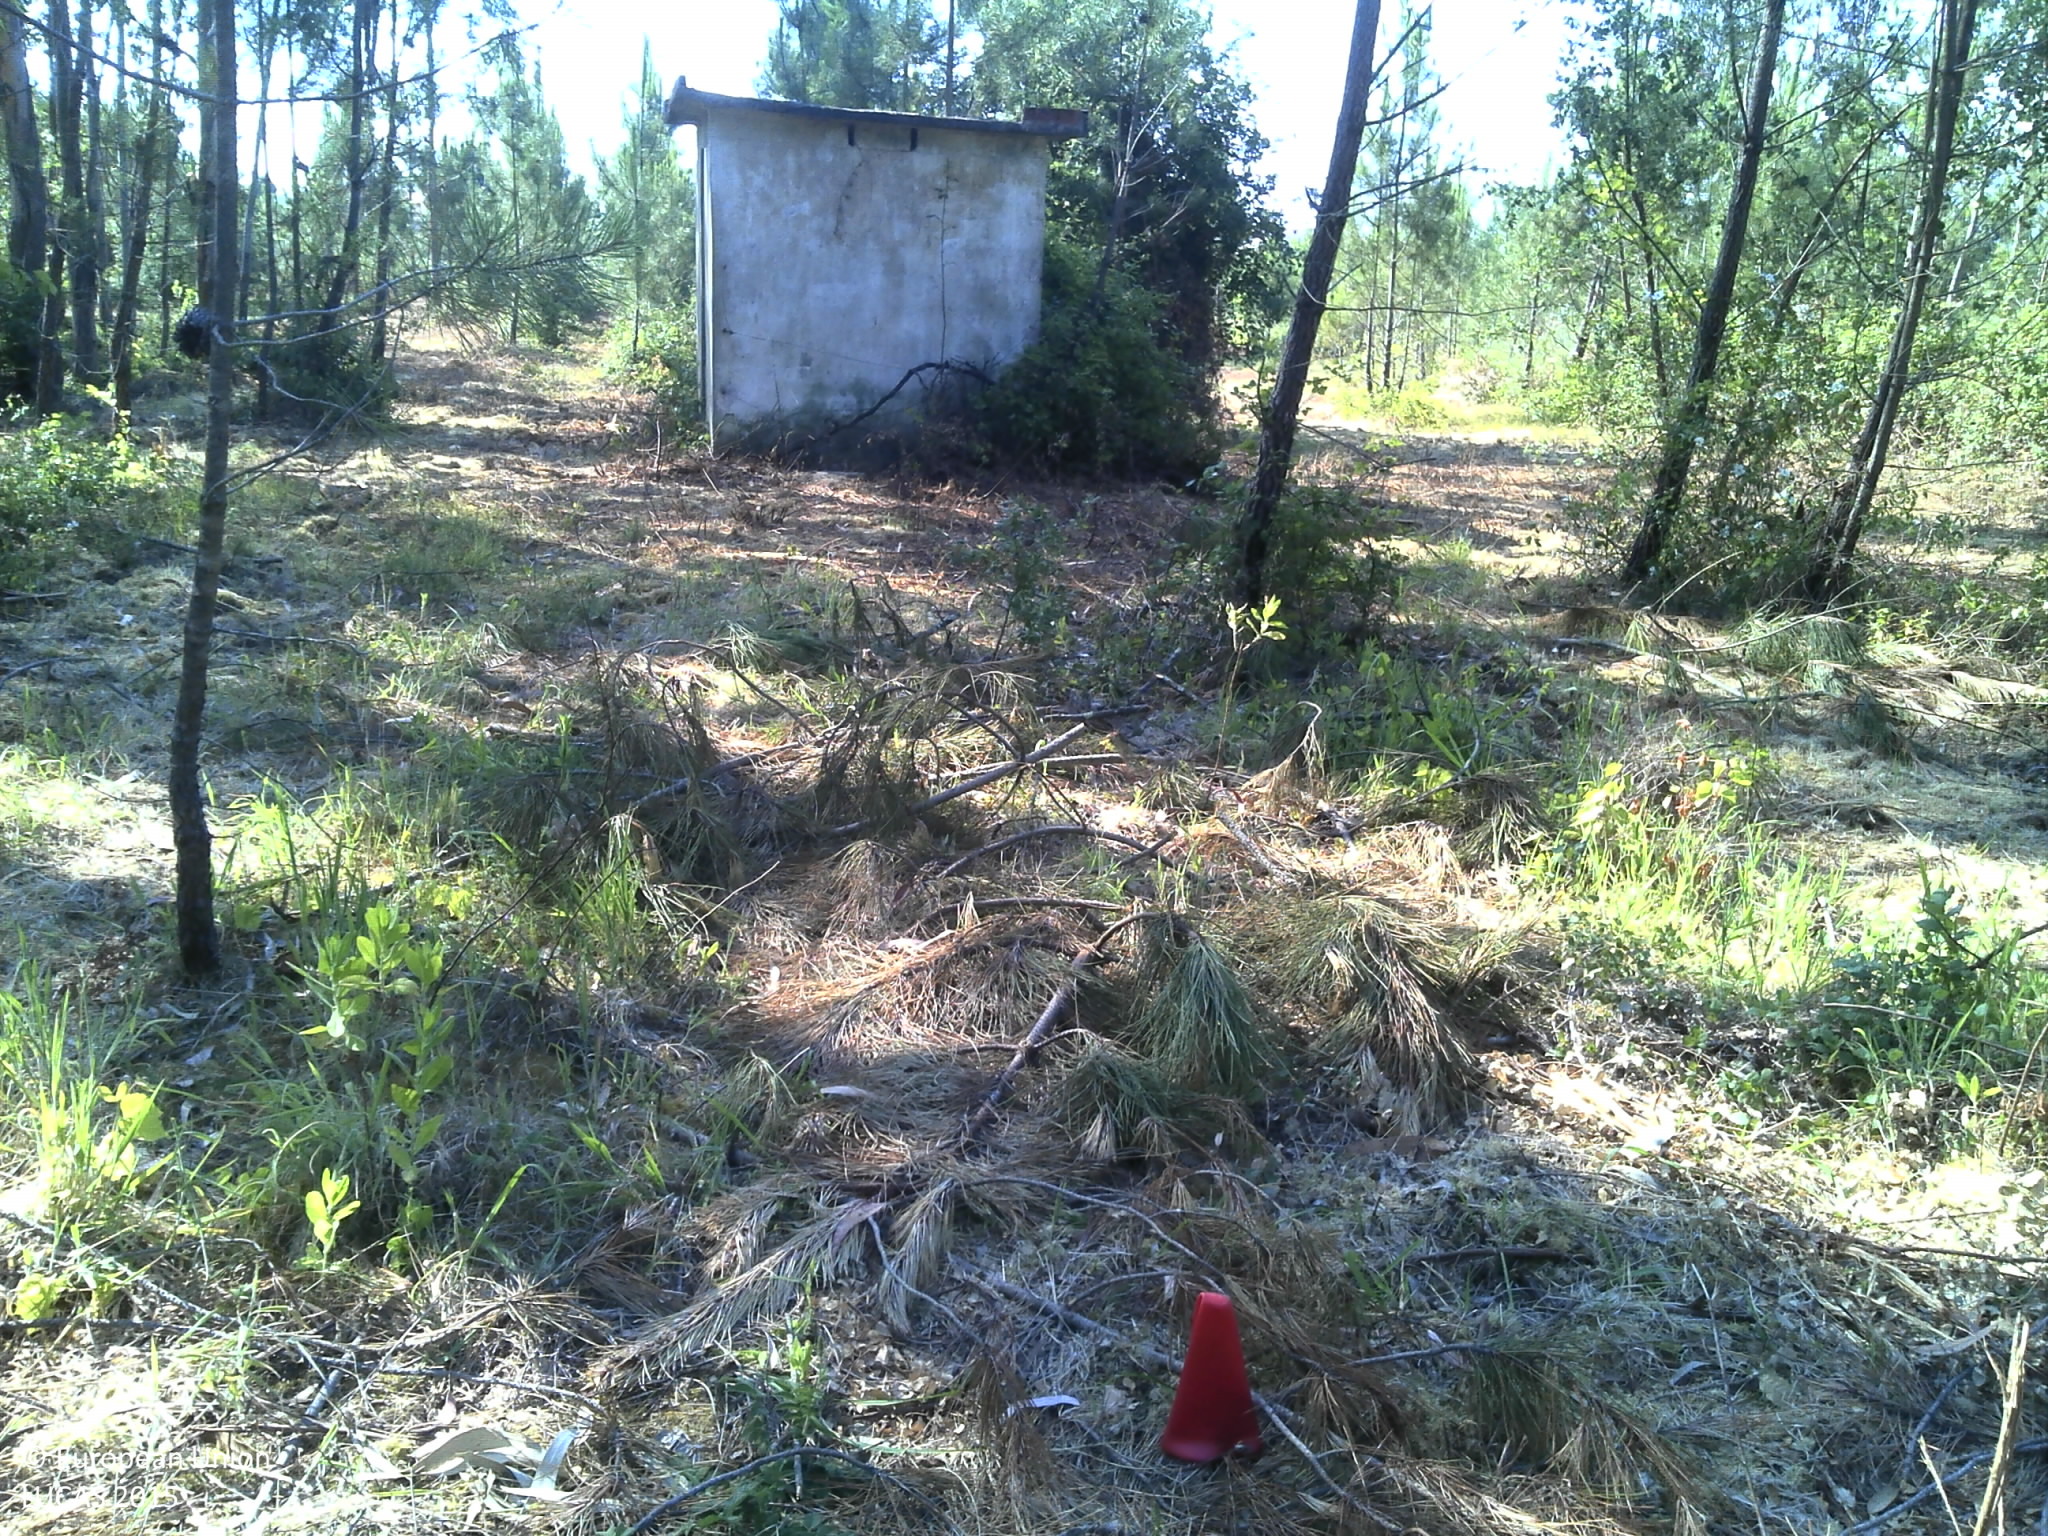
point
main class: Woodland
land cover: Pine dominated coniferous woodland
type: coniferous forest of the mediterranean region
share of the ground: 25 - 50 %
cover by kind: coniferous forest trees 50 %, shrubs 25 %, unconsolidated bare surface 25 %
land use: Forestry
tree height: < 5 m
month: June
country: PT
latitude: 40.3120
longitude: -8.6482
